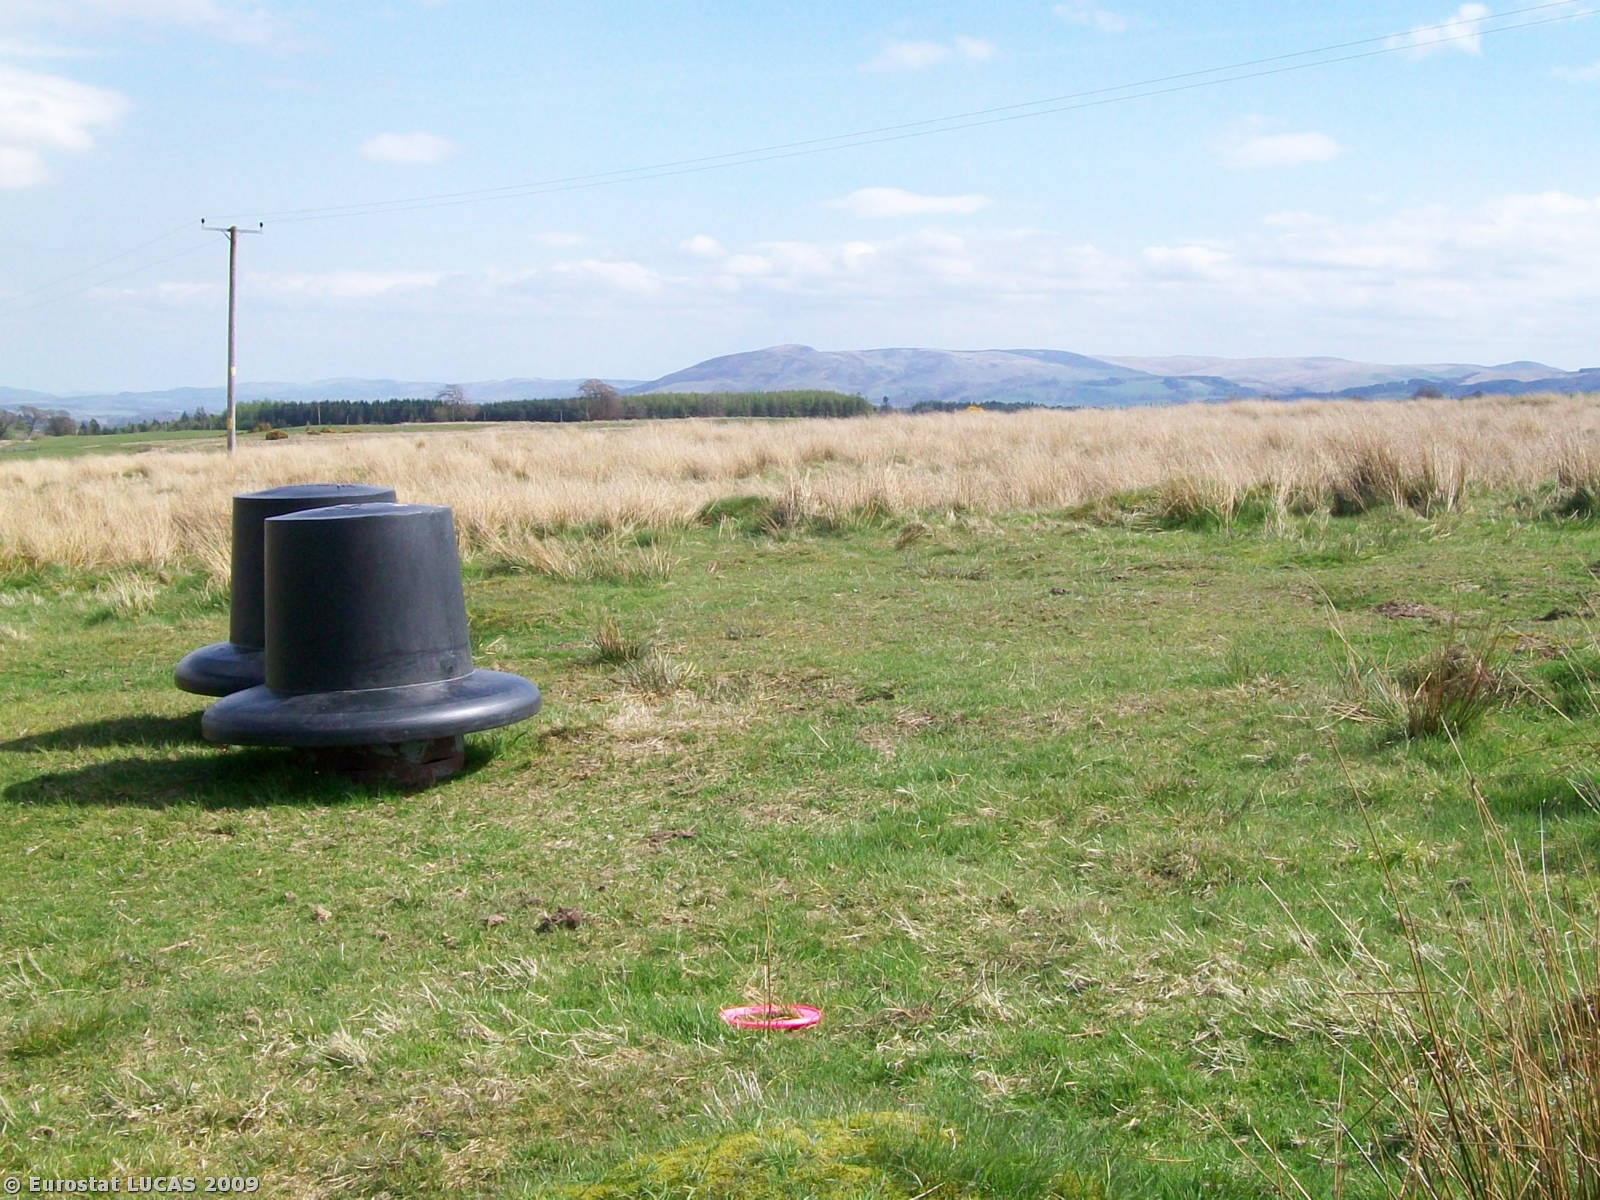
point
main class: Grassland
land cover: Grassland with sparse tree/shrub cover
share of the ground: > 75 %
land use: Agriculture (excluding fallow land and kitchen gardens)
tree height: > 5 m
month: April
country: GB
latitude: 56.2960
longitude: -3.8006
